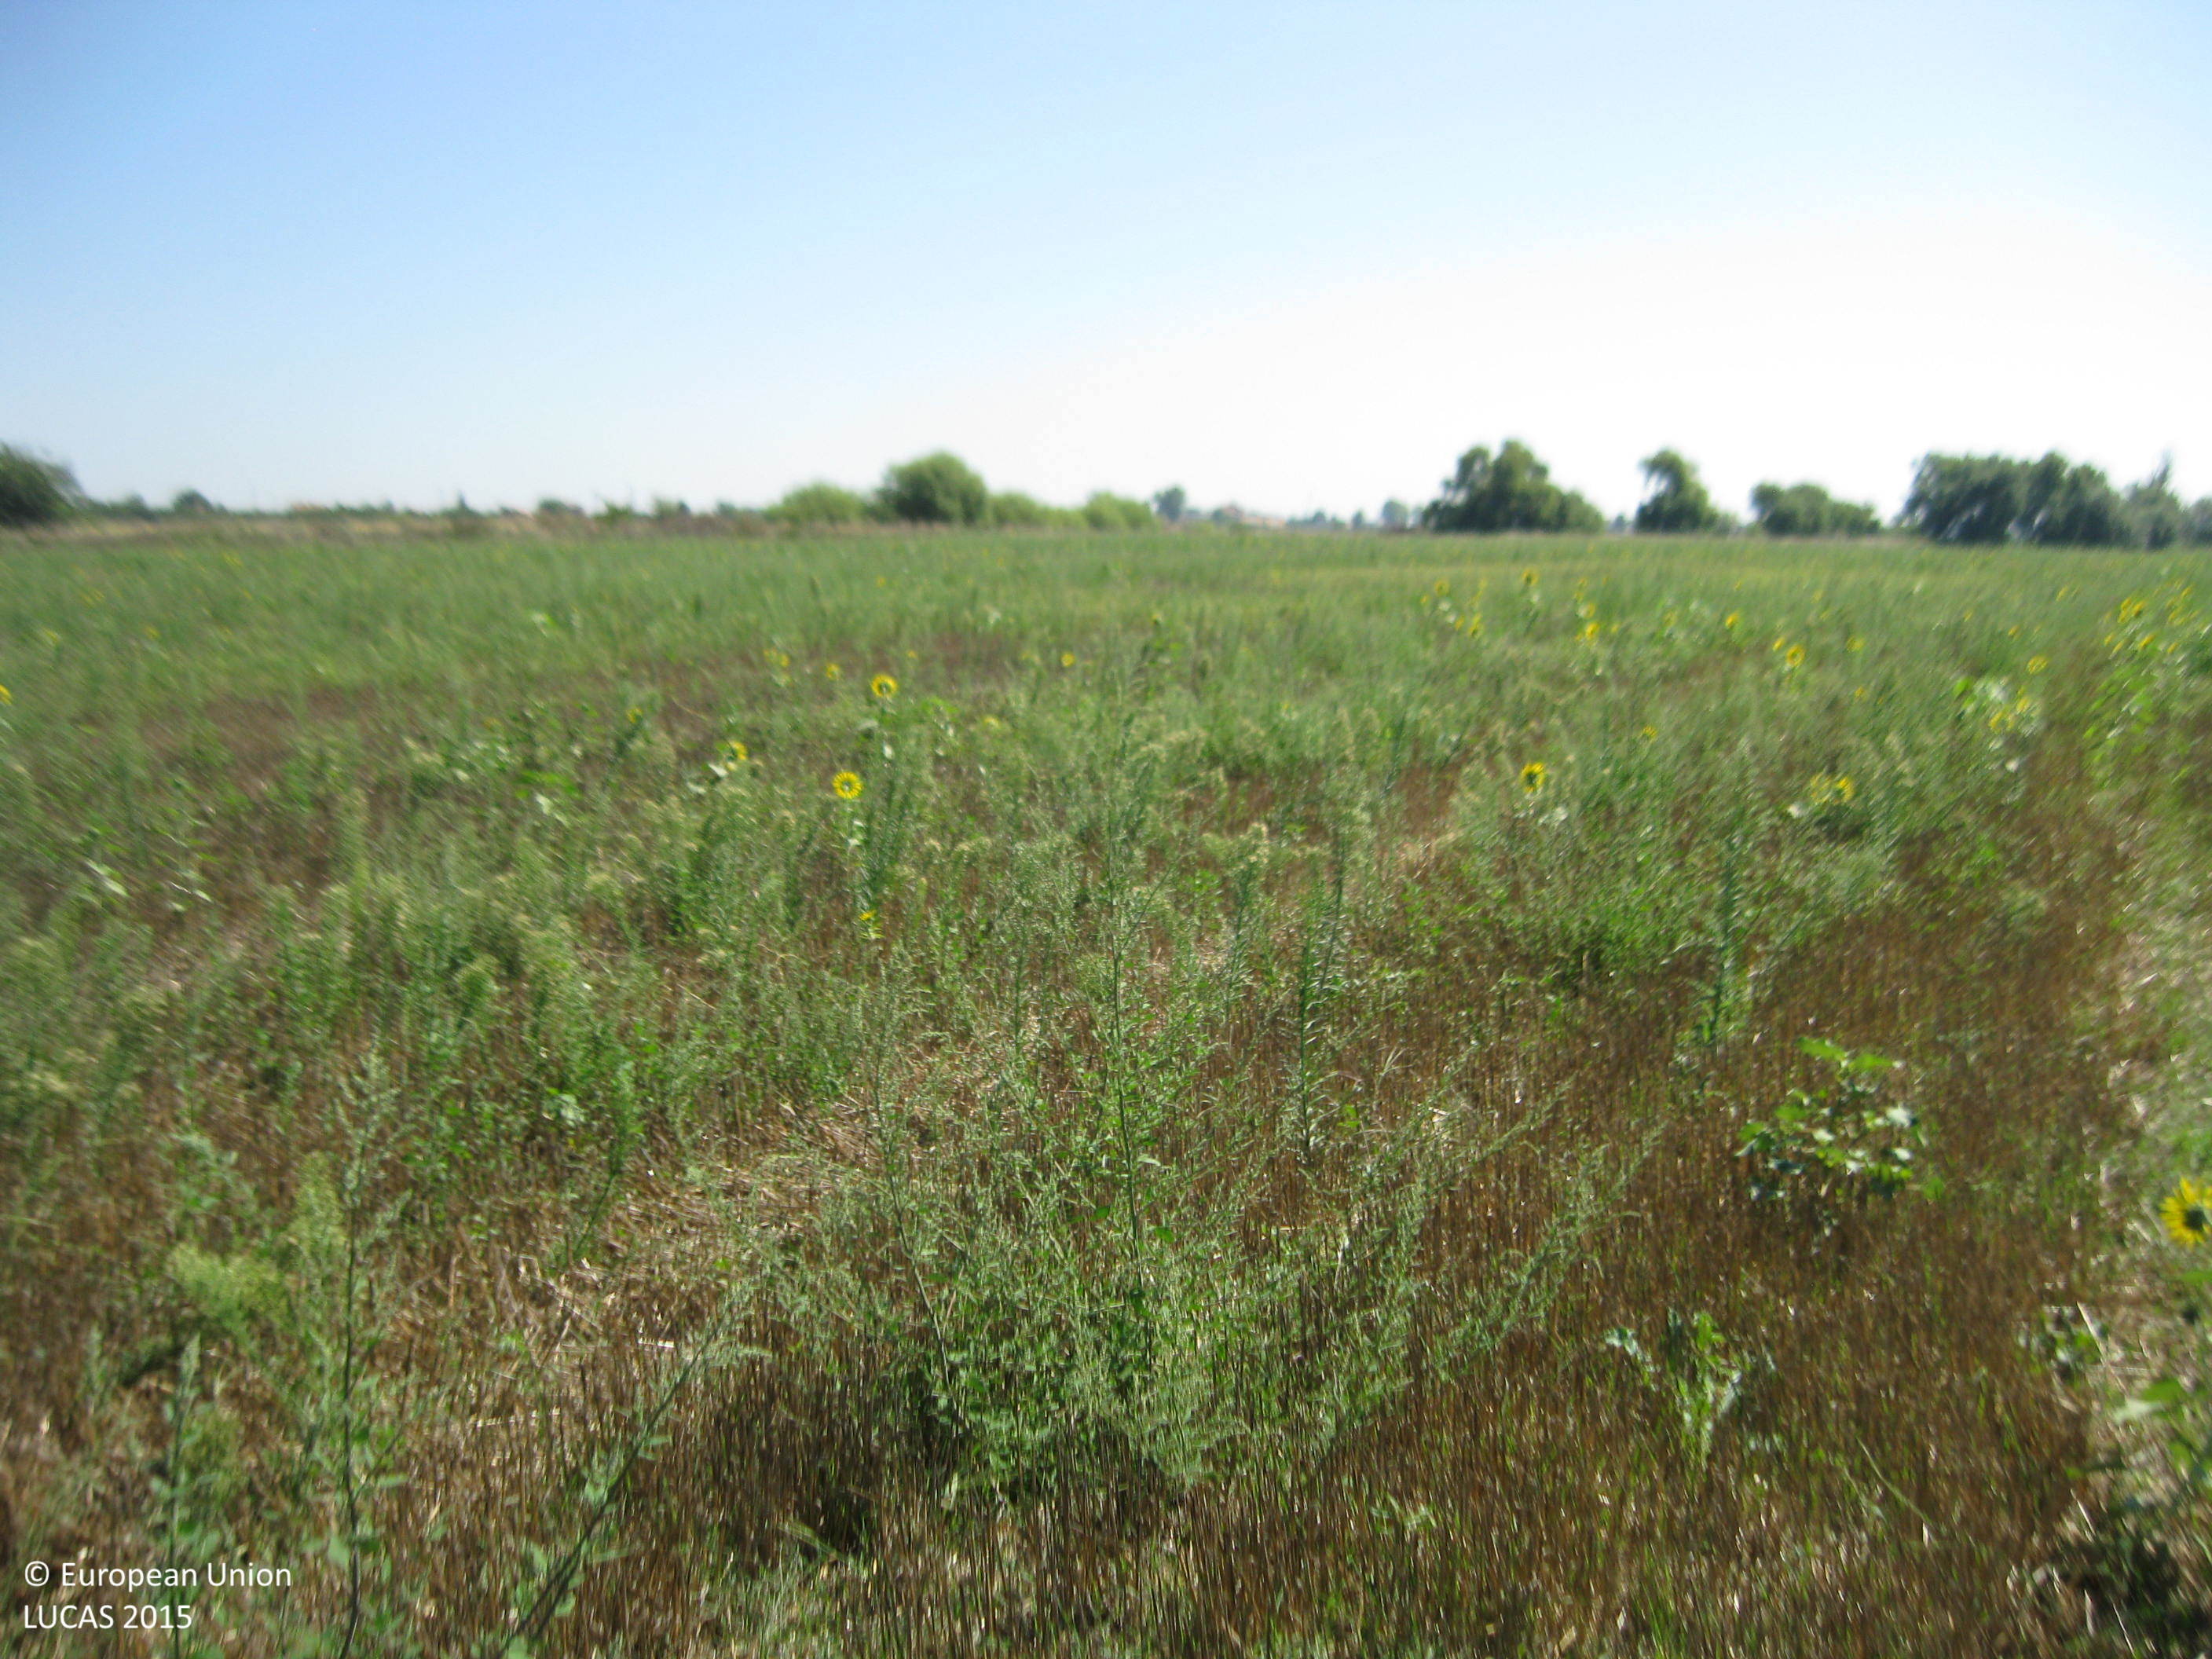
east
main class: Cropland
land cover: Common wheat
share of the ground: 25 - 50 %
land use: Agriculture (excluding fallow land and kitchen gardens)
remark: Harvested field
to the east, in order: Common wheat; Grassland without tree/shrub cover; Rivers and streams; Grassland with sparse tree/shrub cover; Sunflower; Grassland without tree/shrub cover; Tracks; Grassland without tree/shrub cover; Inland fresh running water; Abandoned hedges
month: September
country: BG
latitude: 42.2094
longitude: 24.6214
